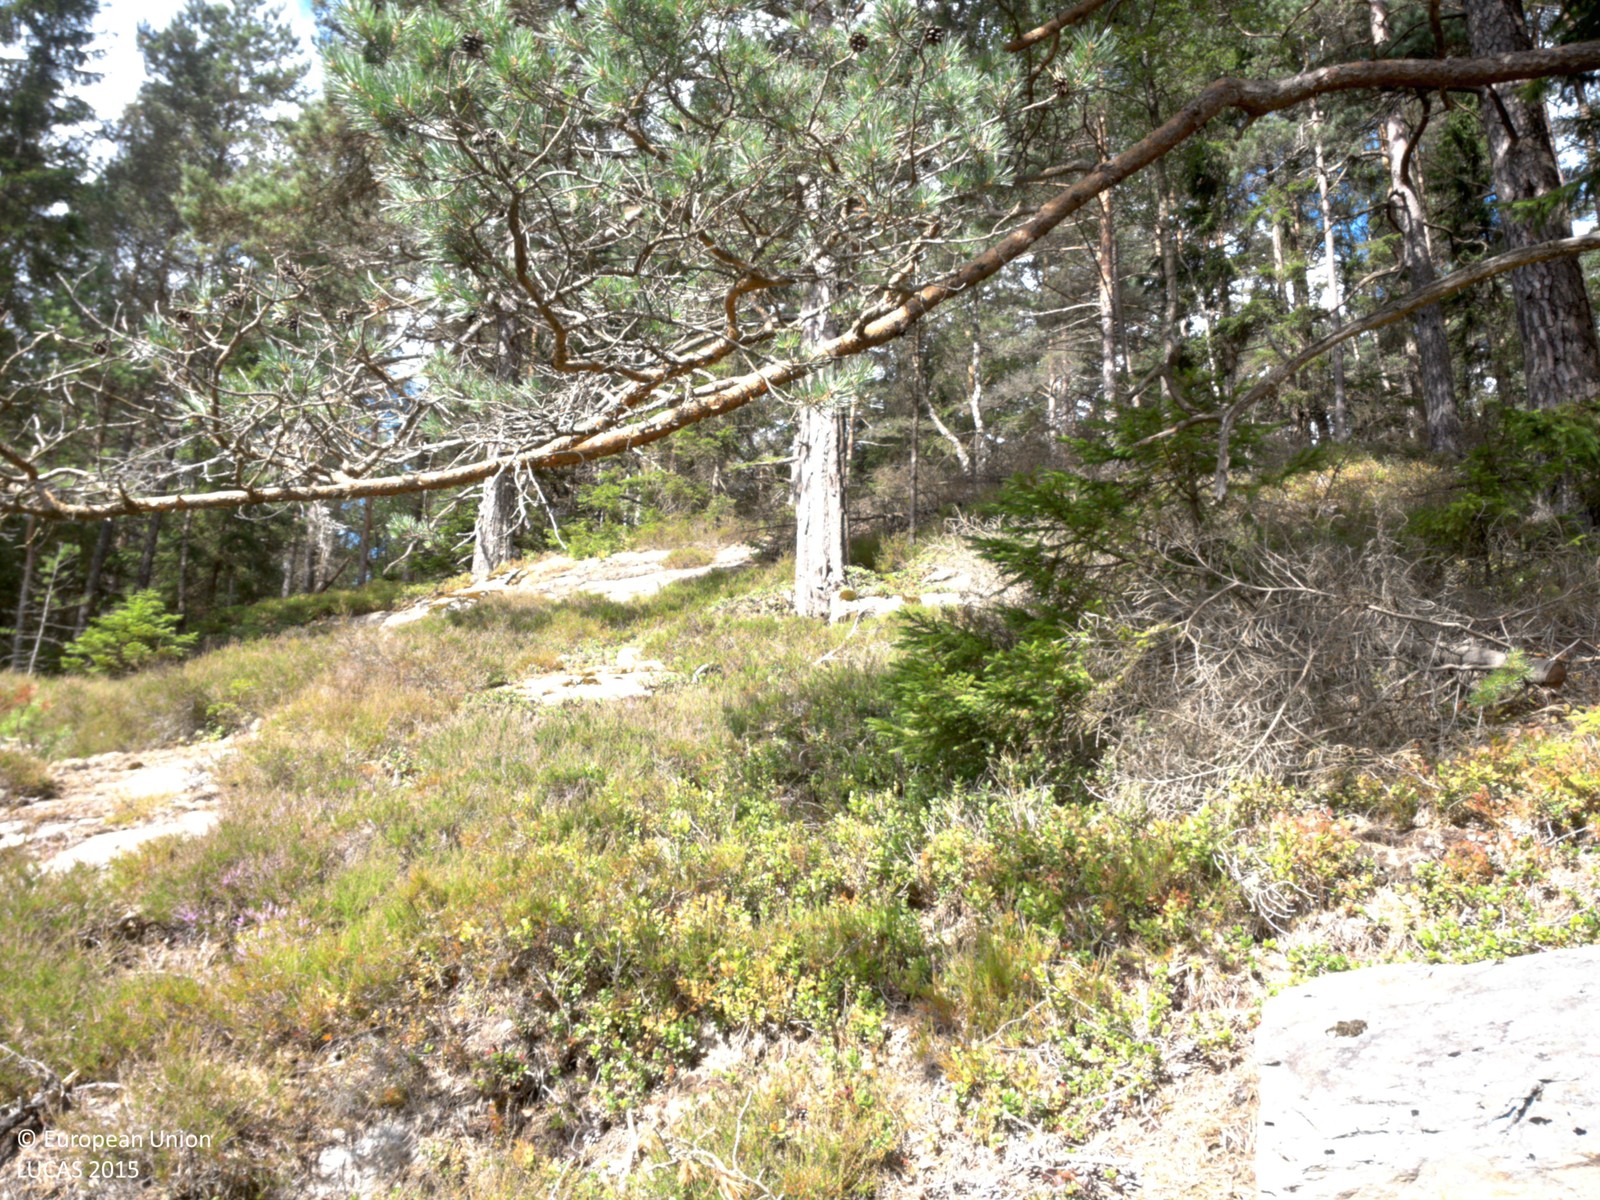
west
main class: Woodland
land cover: Other coniferous woodland
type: boreal forest
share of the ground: 25 - 50 %
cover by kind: coniferous forest trees 40 %, shrubs 35 %, lichens and mosses 10 %, unconsolidated bare surface 10 %, broadleaved forest trees 5 %
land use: Forestry
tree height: > 5 m
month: July
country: SE
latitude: 58.2436
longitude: 11.7852
